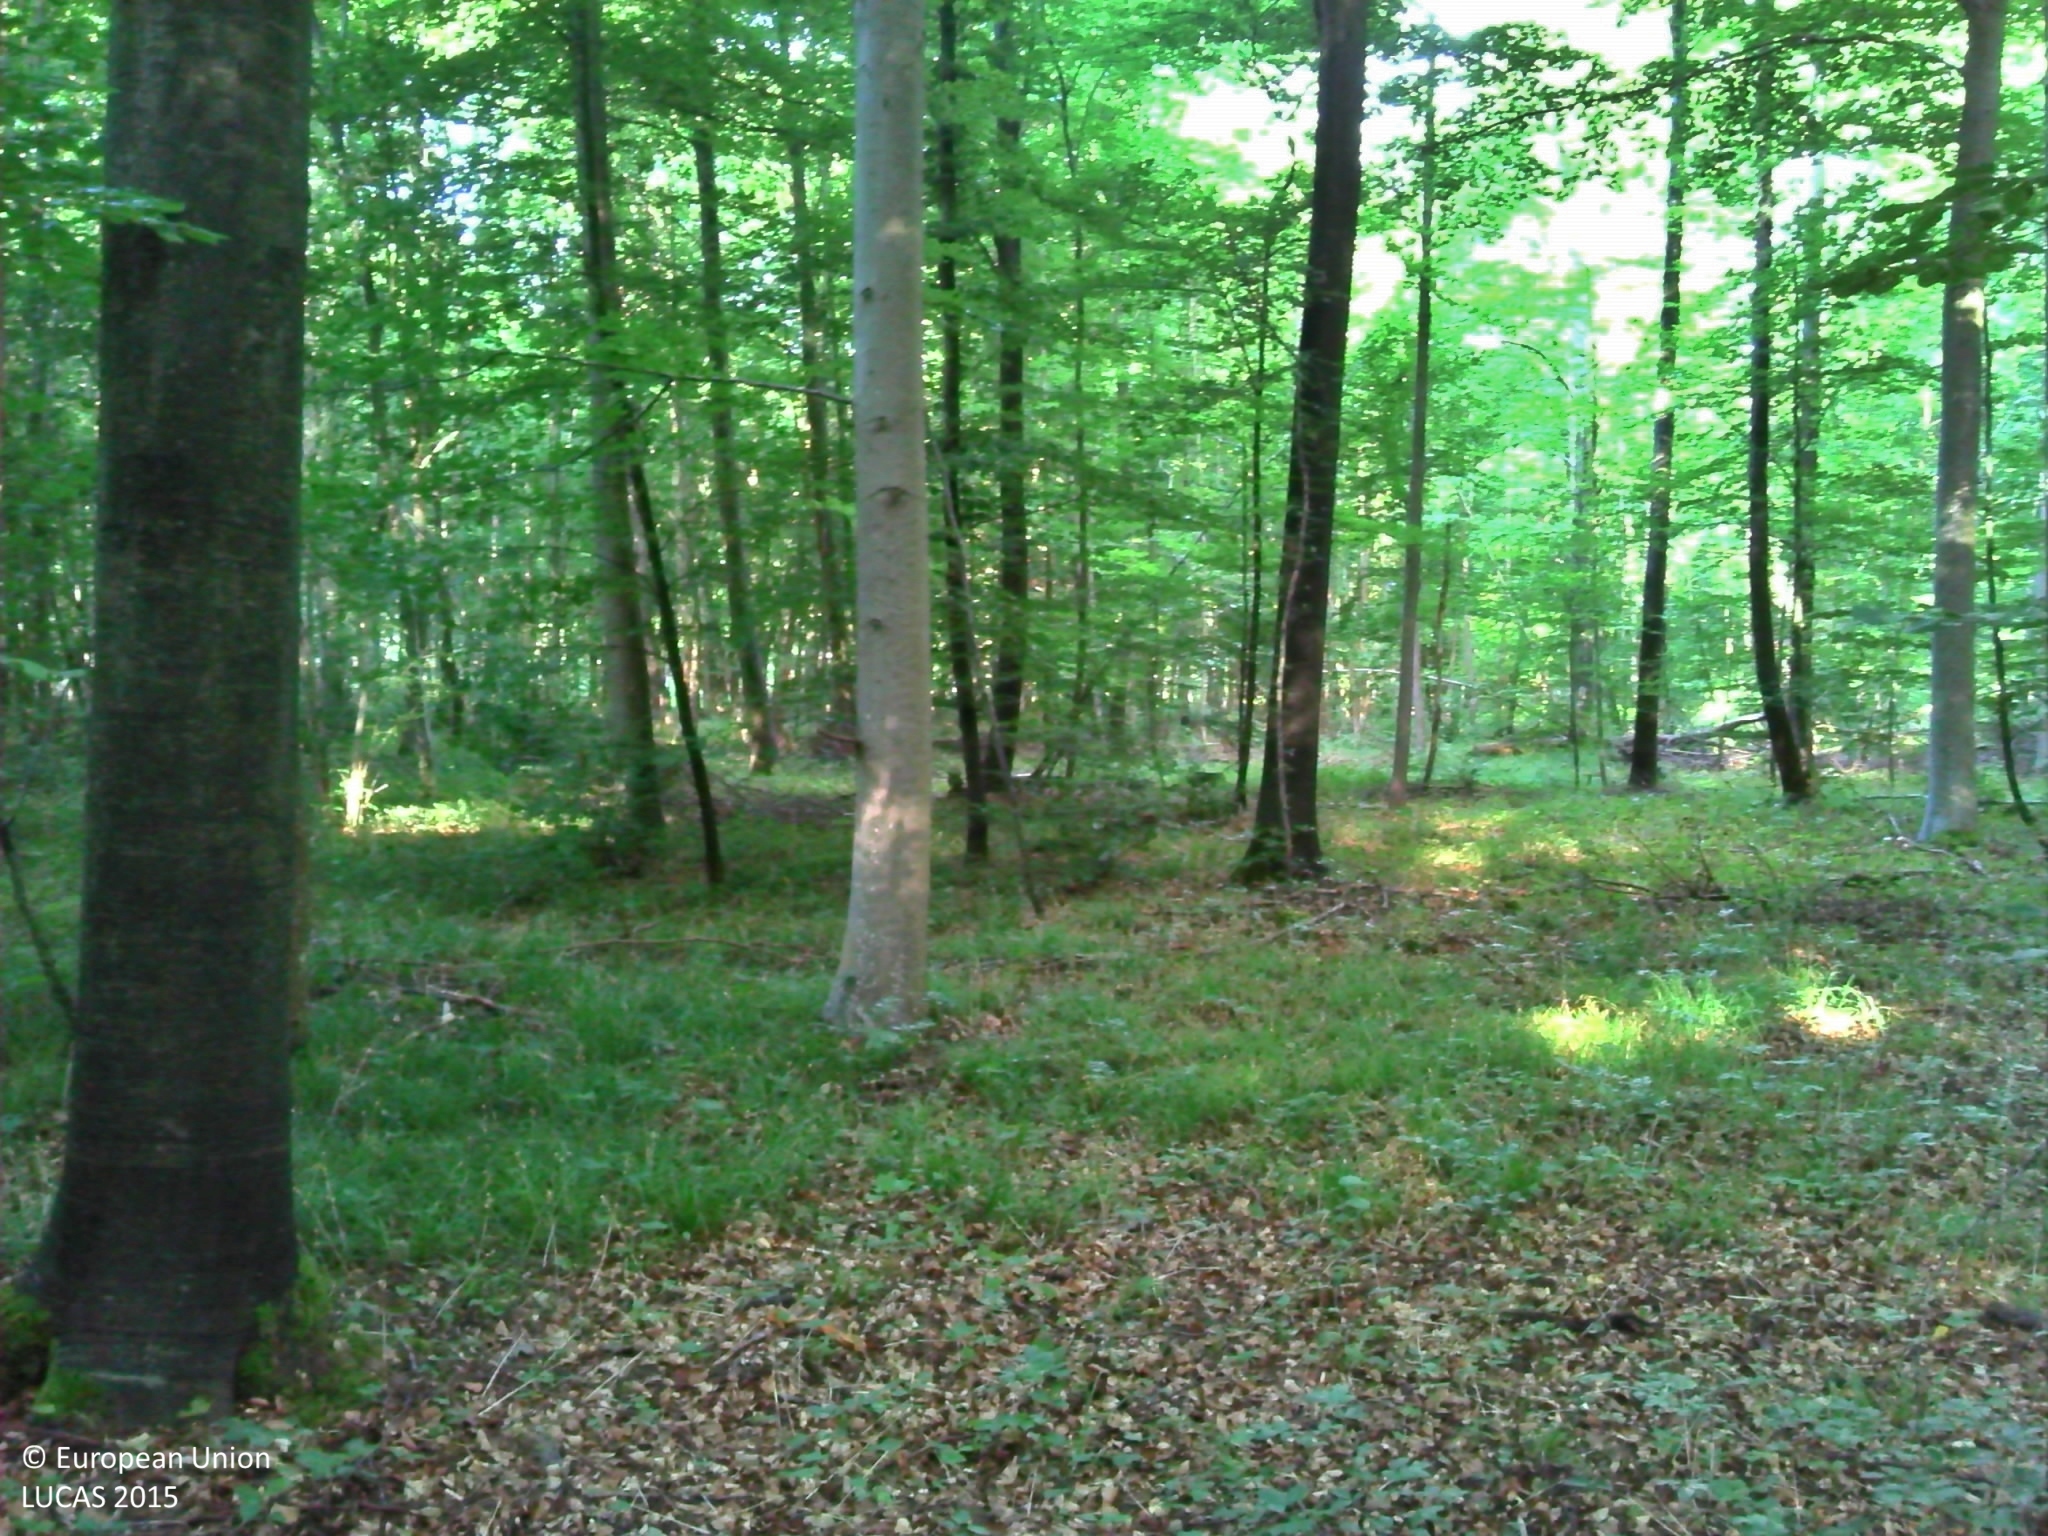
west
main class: Woodland
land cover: Broadleaved woodland
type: beech forest
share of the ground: > 75 %
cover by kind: broadleaved forest trees 90 %, herbaceous plants 10 %
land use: Forestry
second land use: Amenities, museums, leisure
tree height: > 5 m
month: July
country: FR
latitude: 49.2401
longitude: 2.6131
